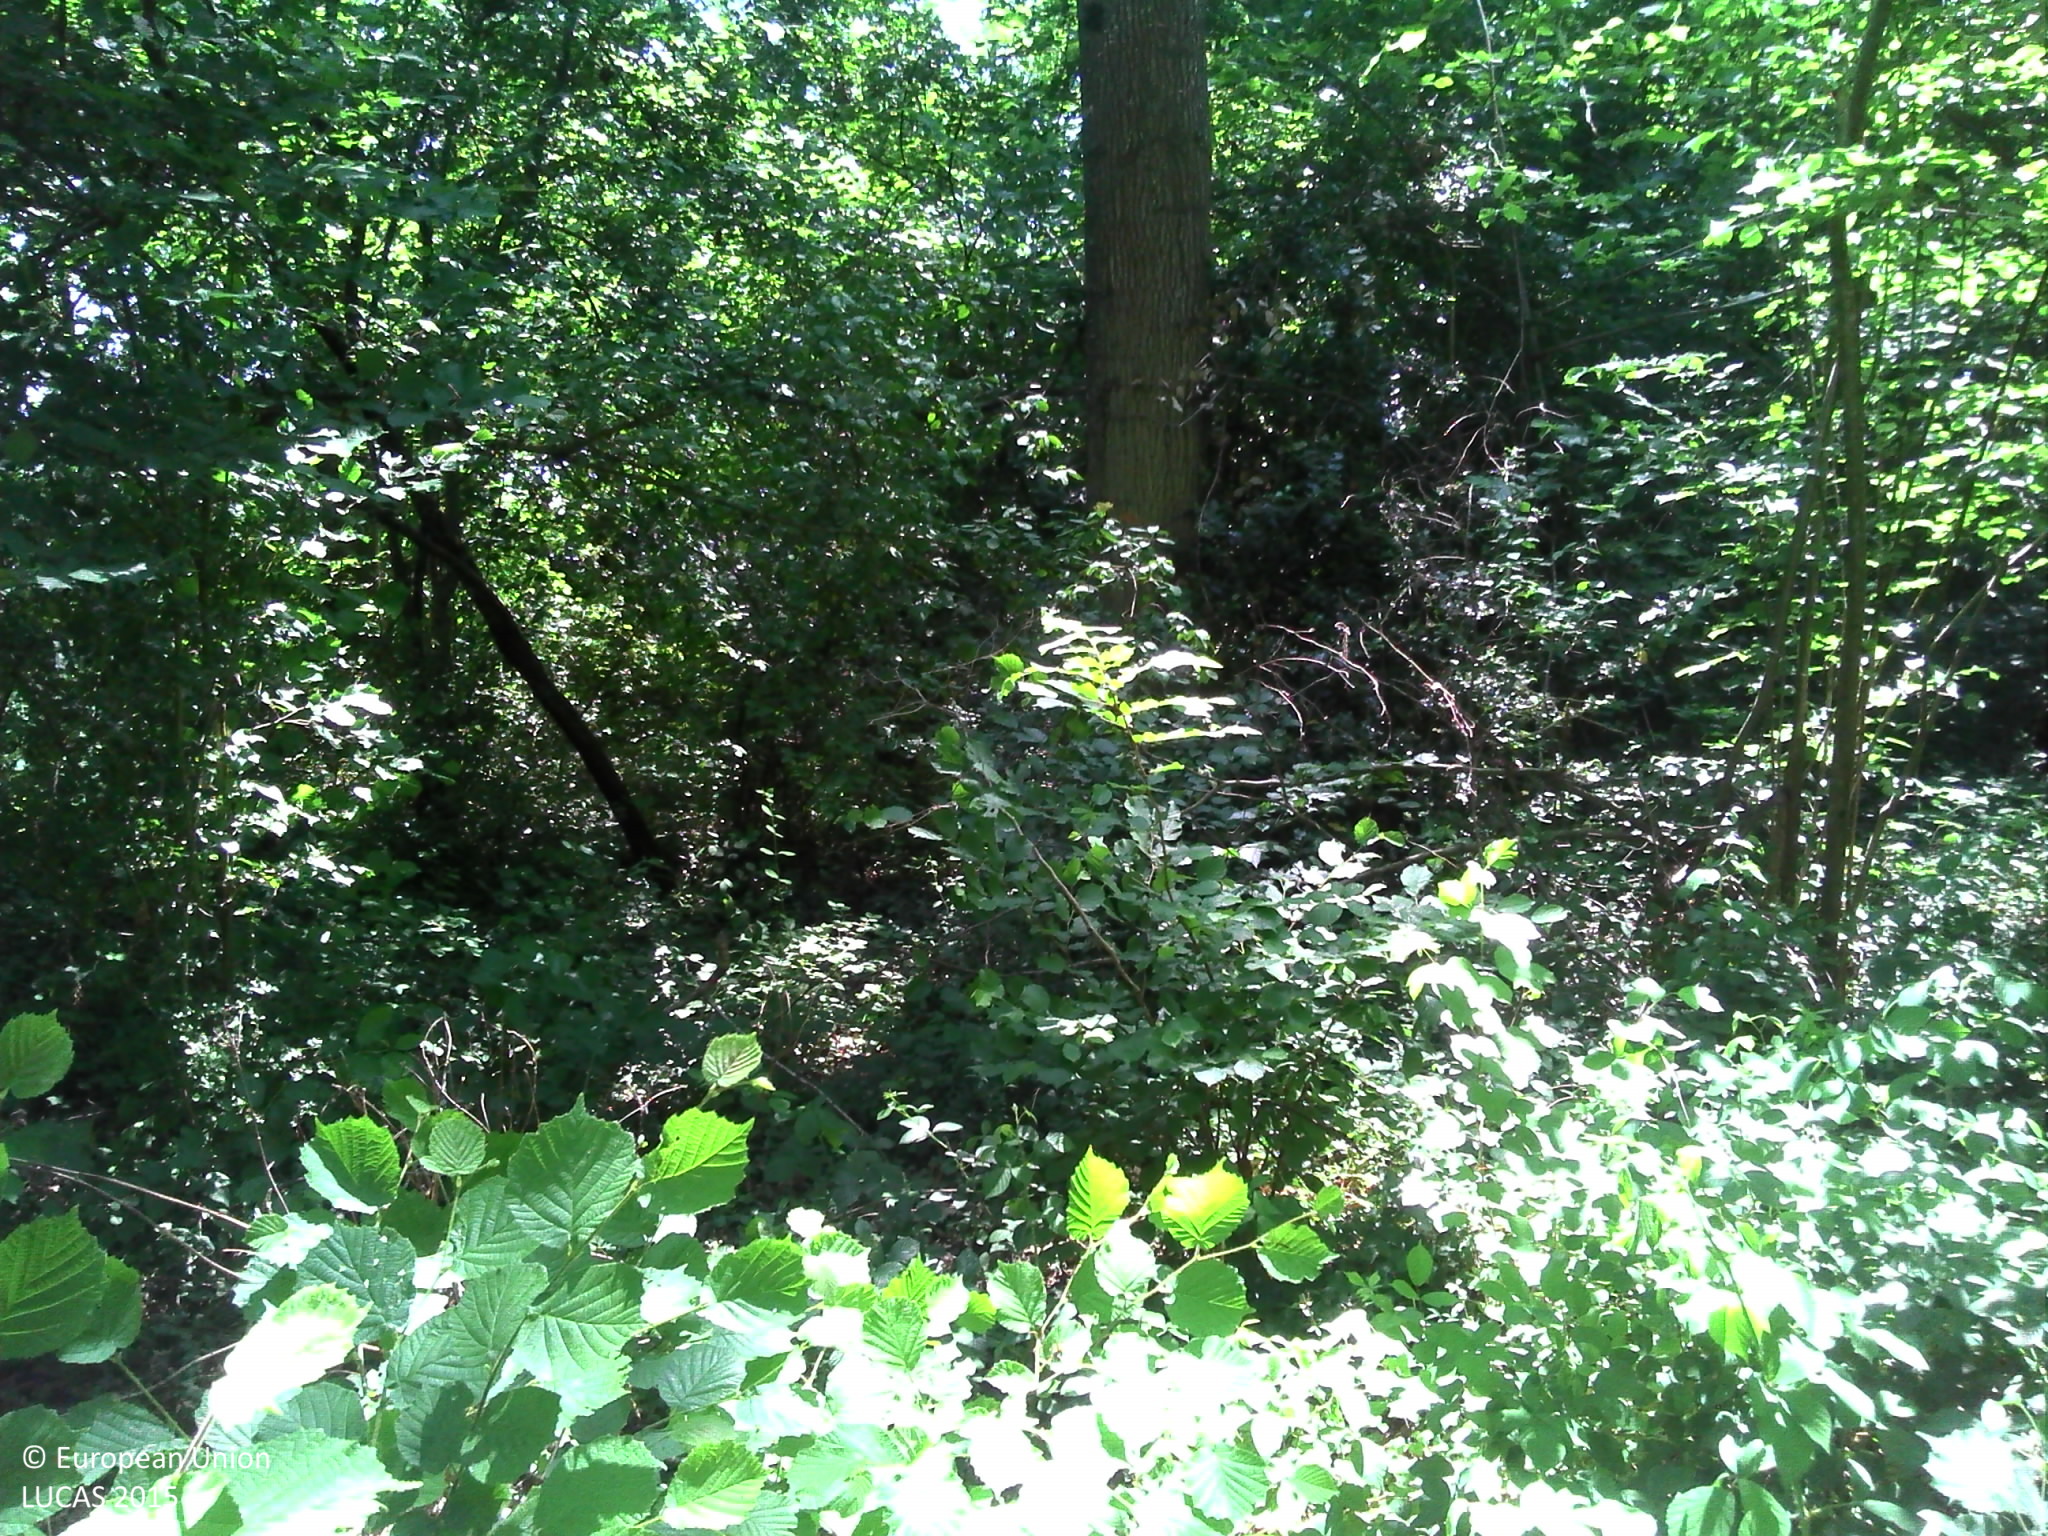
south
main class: Woodland
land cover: Broadleaved woodland
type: mesophytic deciduous forest
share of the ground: > 75 %
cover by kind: broadleaved forest trees 80 %, herbaceous plants 20 %
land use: Forestry
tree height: > 5 m
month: June
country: FR
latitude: 46.0298
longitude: 4.8740
